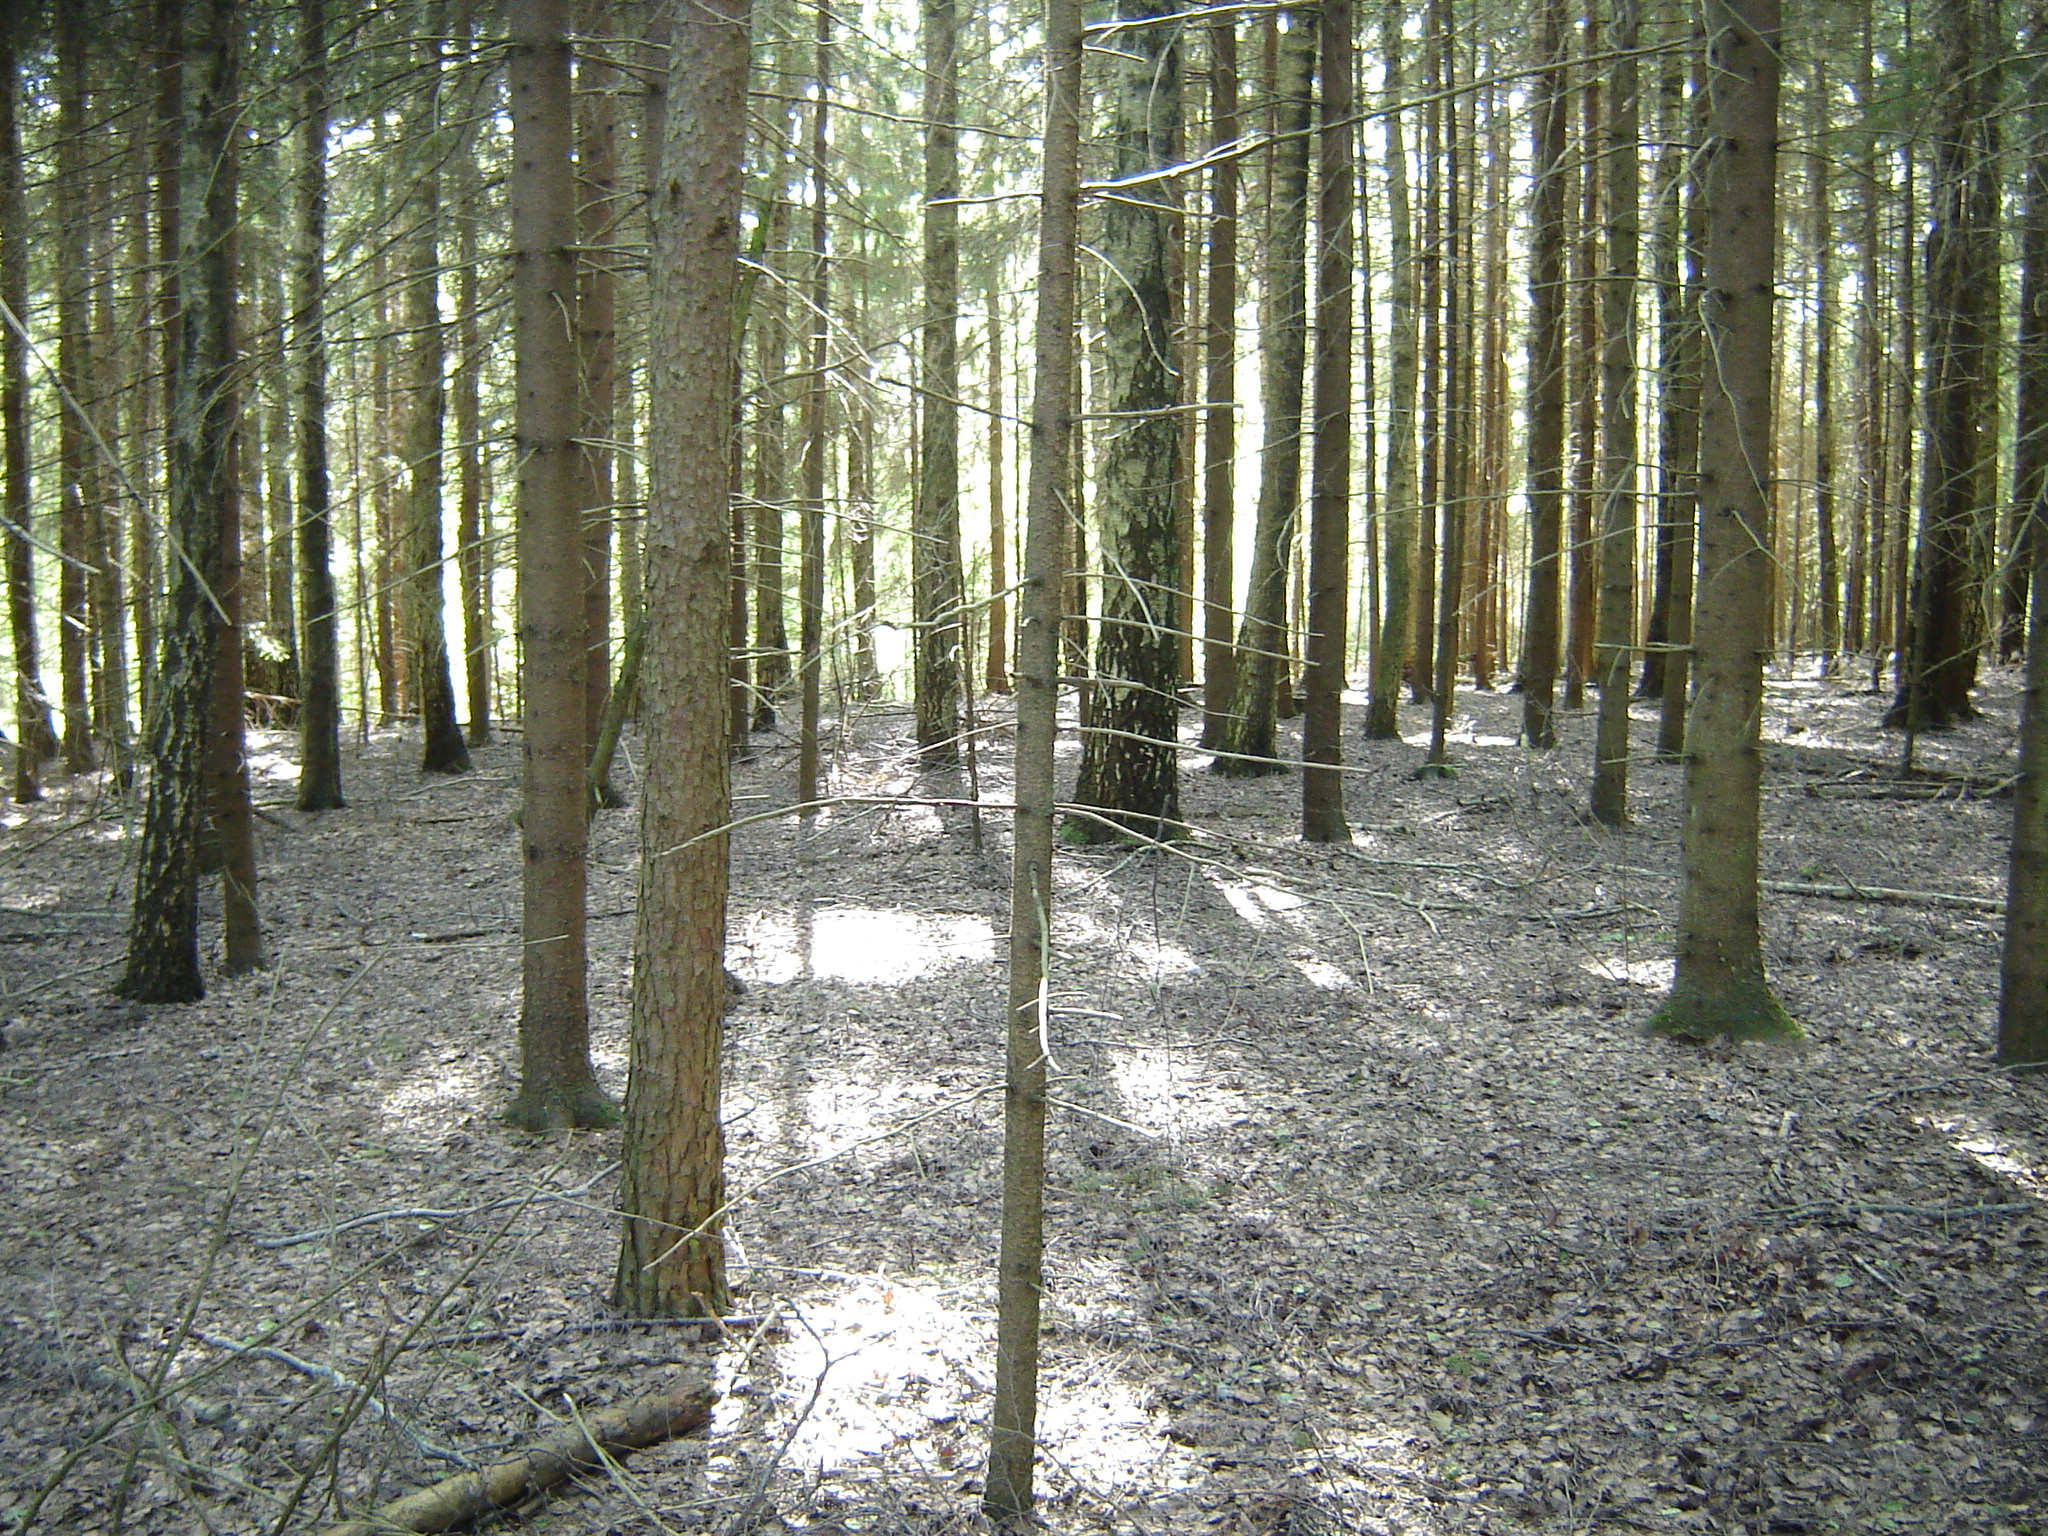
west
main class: Woodland
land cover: Spruce dominated coniferous woodland
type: hemiboreal forest and nemoral coniferous forest and mixed broadleaved-coniferous forest
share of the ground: > 75 %
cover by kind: coniferous forest trees 75 %, broadleaved forest trees 25 %
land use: Forestry
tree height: > 5 m
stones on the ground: < 10 %
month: May
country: LT
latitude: 55.7507
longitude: 25.2037
